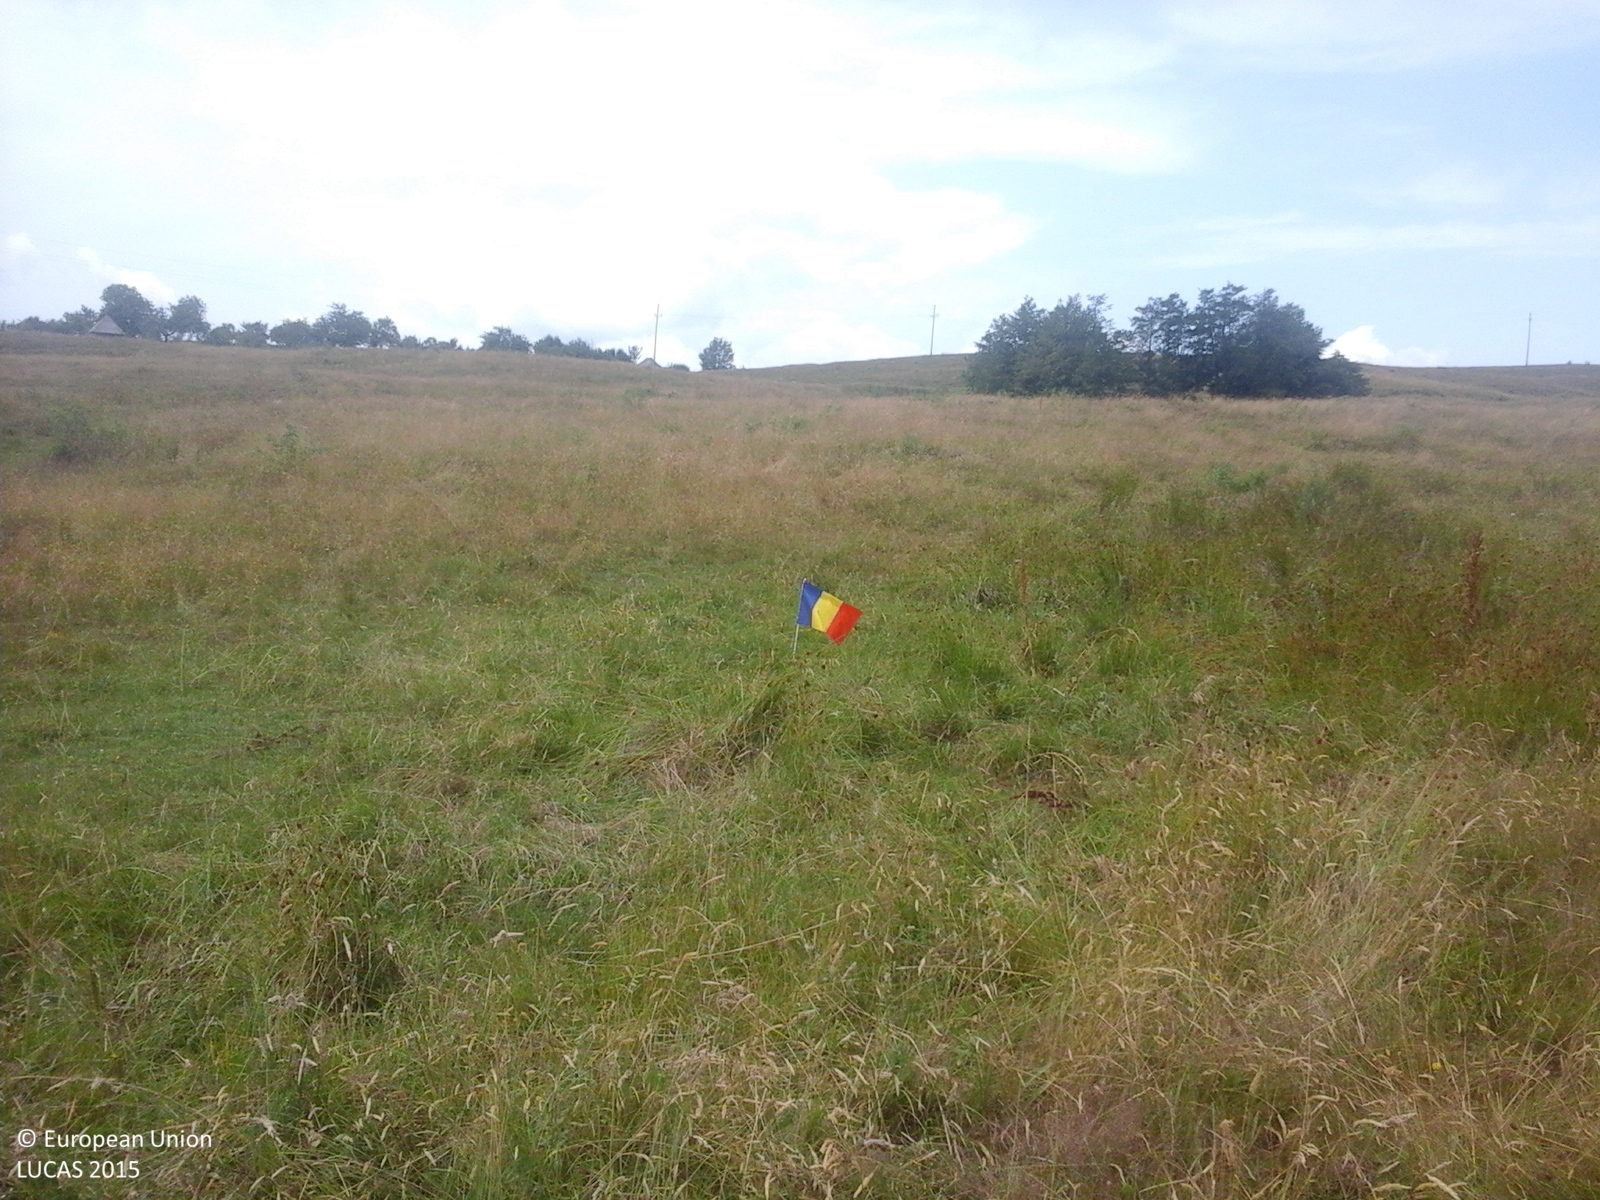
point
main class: Grassland
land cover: Grassland without tree/shrub cover
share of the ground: > 75 %
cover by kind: herbaceous plants 100 %
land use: Agriculture (excluding fallow land and kitchen gardens)
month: July
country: RO
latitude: 45.2171
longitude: 24.5829
